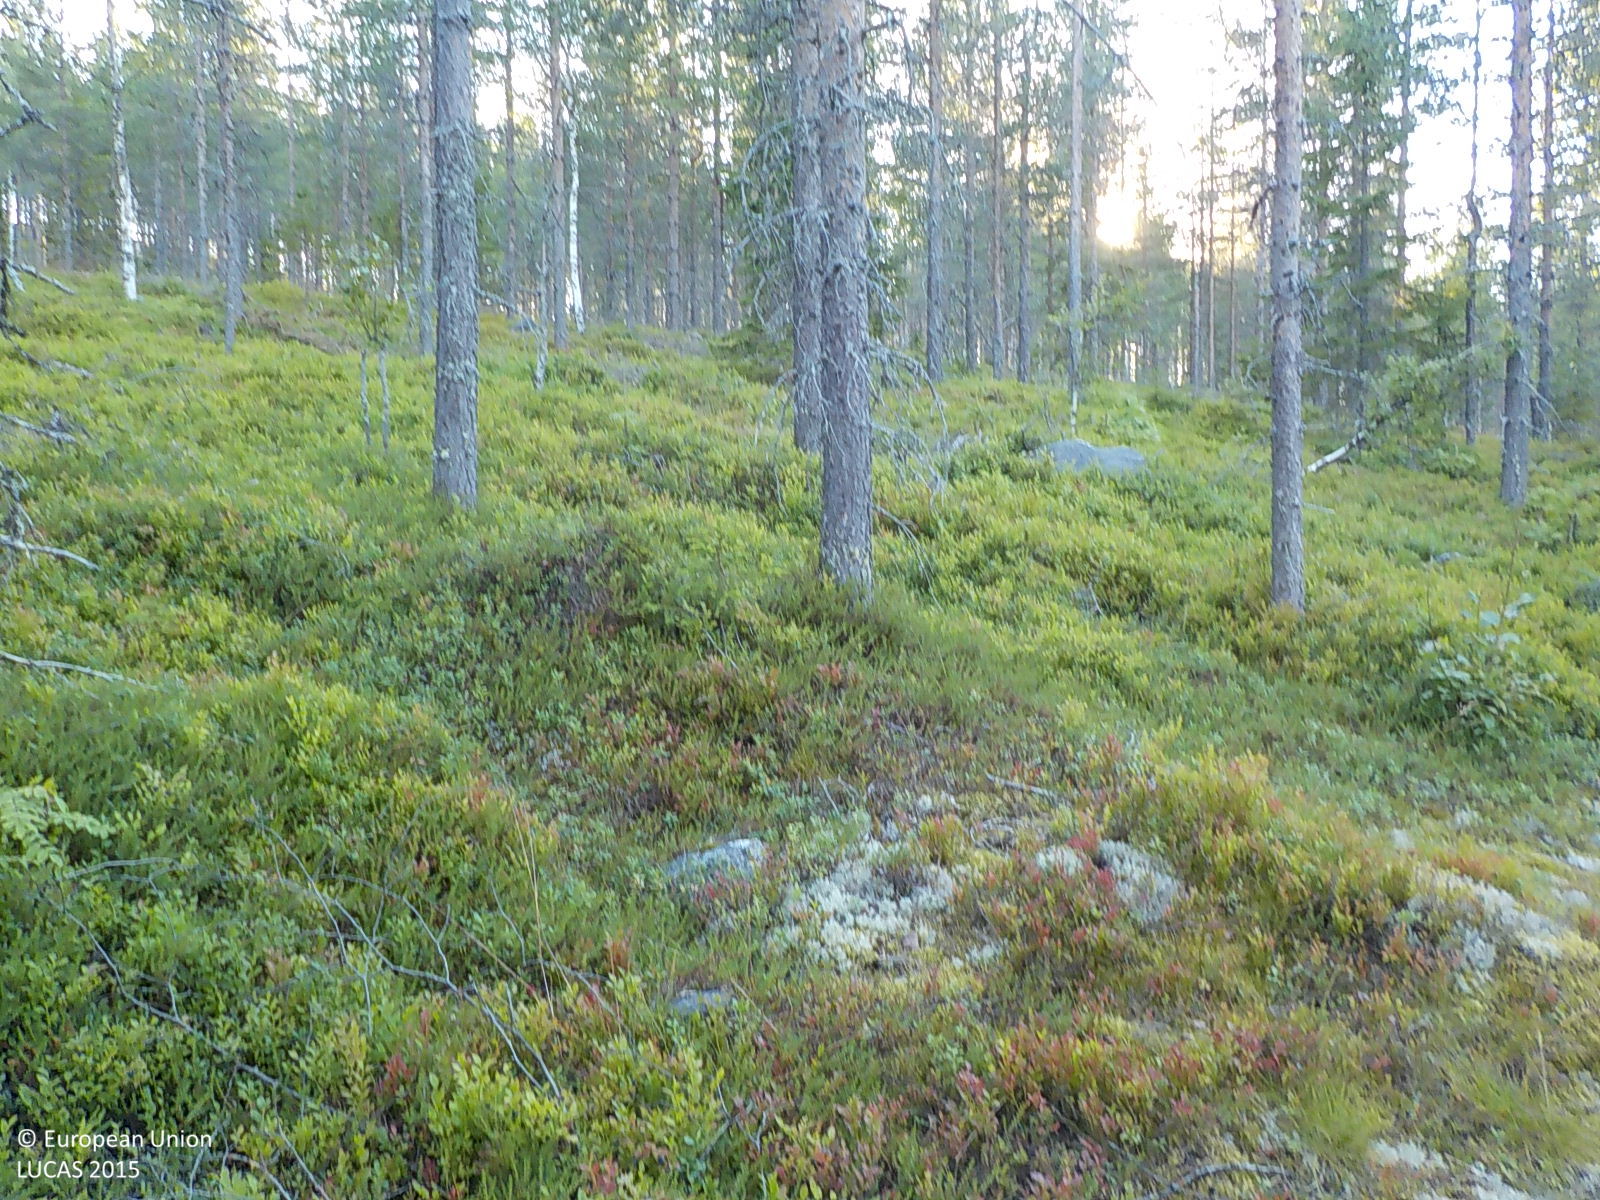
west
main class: Woodland
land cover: Pine dominated coniferous woodland
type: boreal forest
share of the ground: 50 - 75 %
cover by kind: coniferous forest trees 50 %, shrubs 30 %, herbaceous plants 10 %, lichens and mosses 10 %
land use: Forestry
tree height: > 5 m
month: August
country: SE
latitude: 63.4703
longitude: 18.6658
